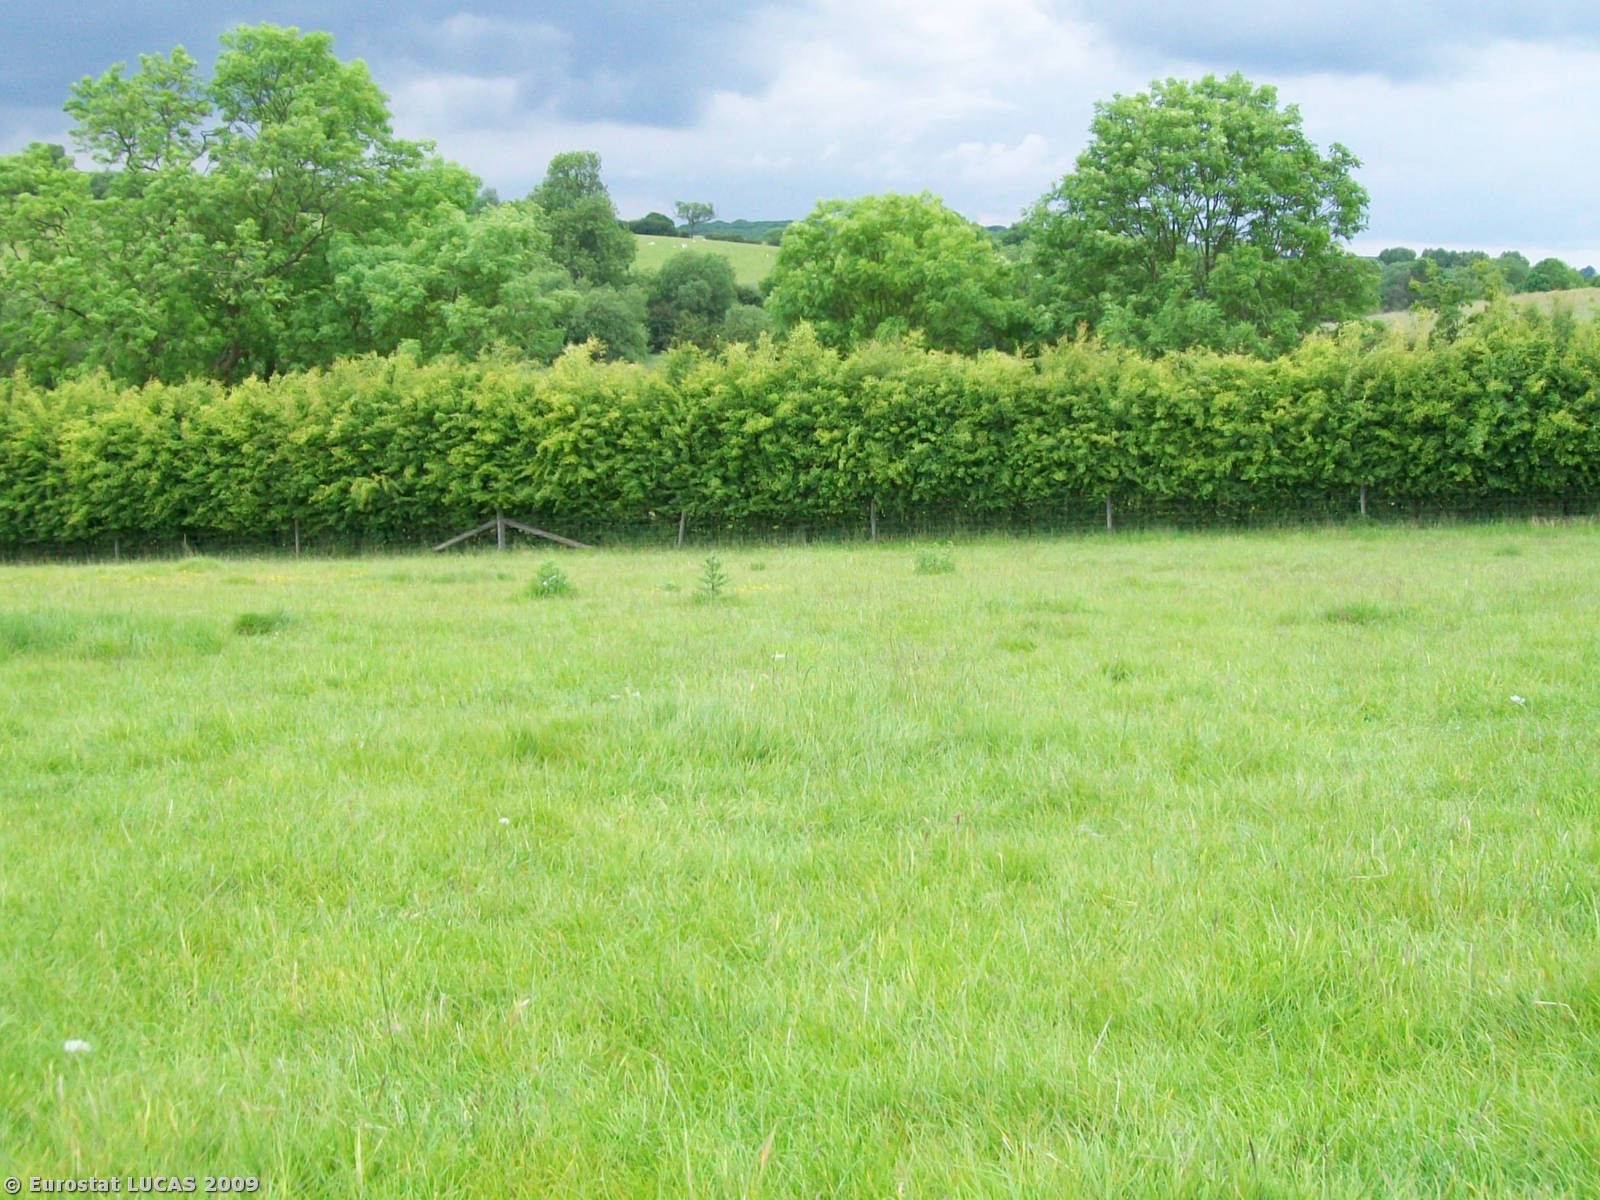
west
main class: Grassland
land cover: Grassland without tree/shrub cover
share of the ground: > 75 %
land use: Agriculture (excluding fallow land and kitchen gardens)
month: June
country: GB
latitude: 52.6287
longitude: -0.7821
